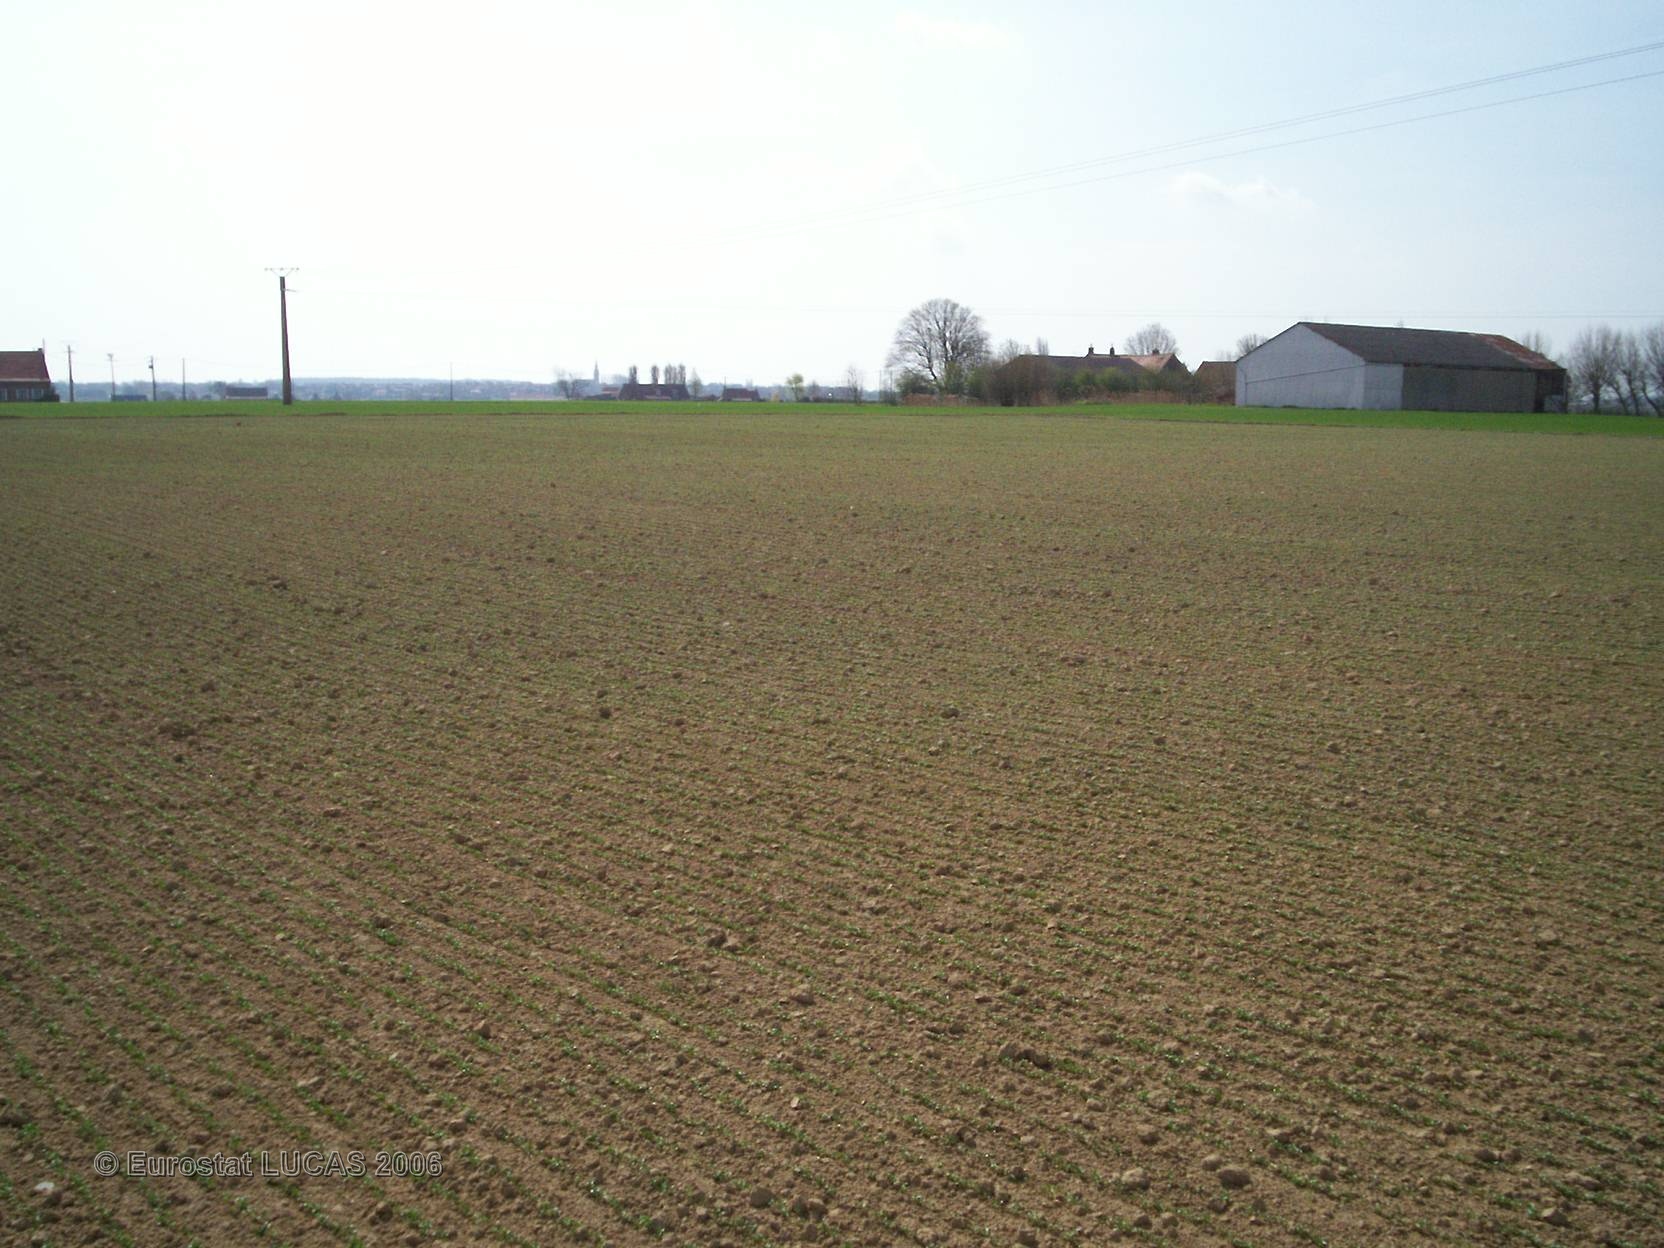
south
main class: Cropland
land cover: Other fibre and oleaginous crops
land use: Agriculture (excluding fallow land and kitchen gardens)
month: April
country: FR
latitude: 50.7472
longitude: 2.4614
